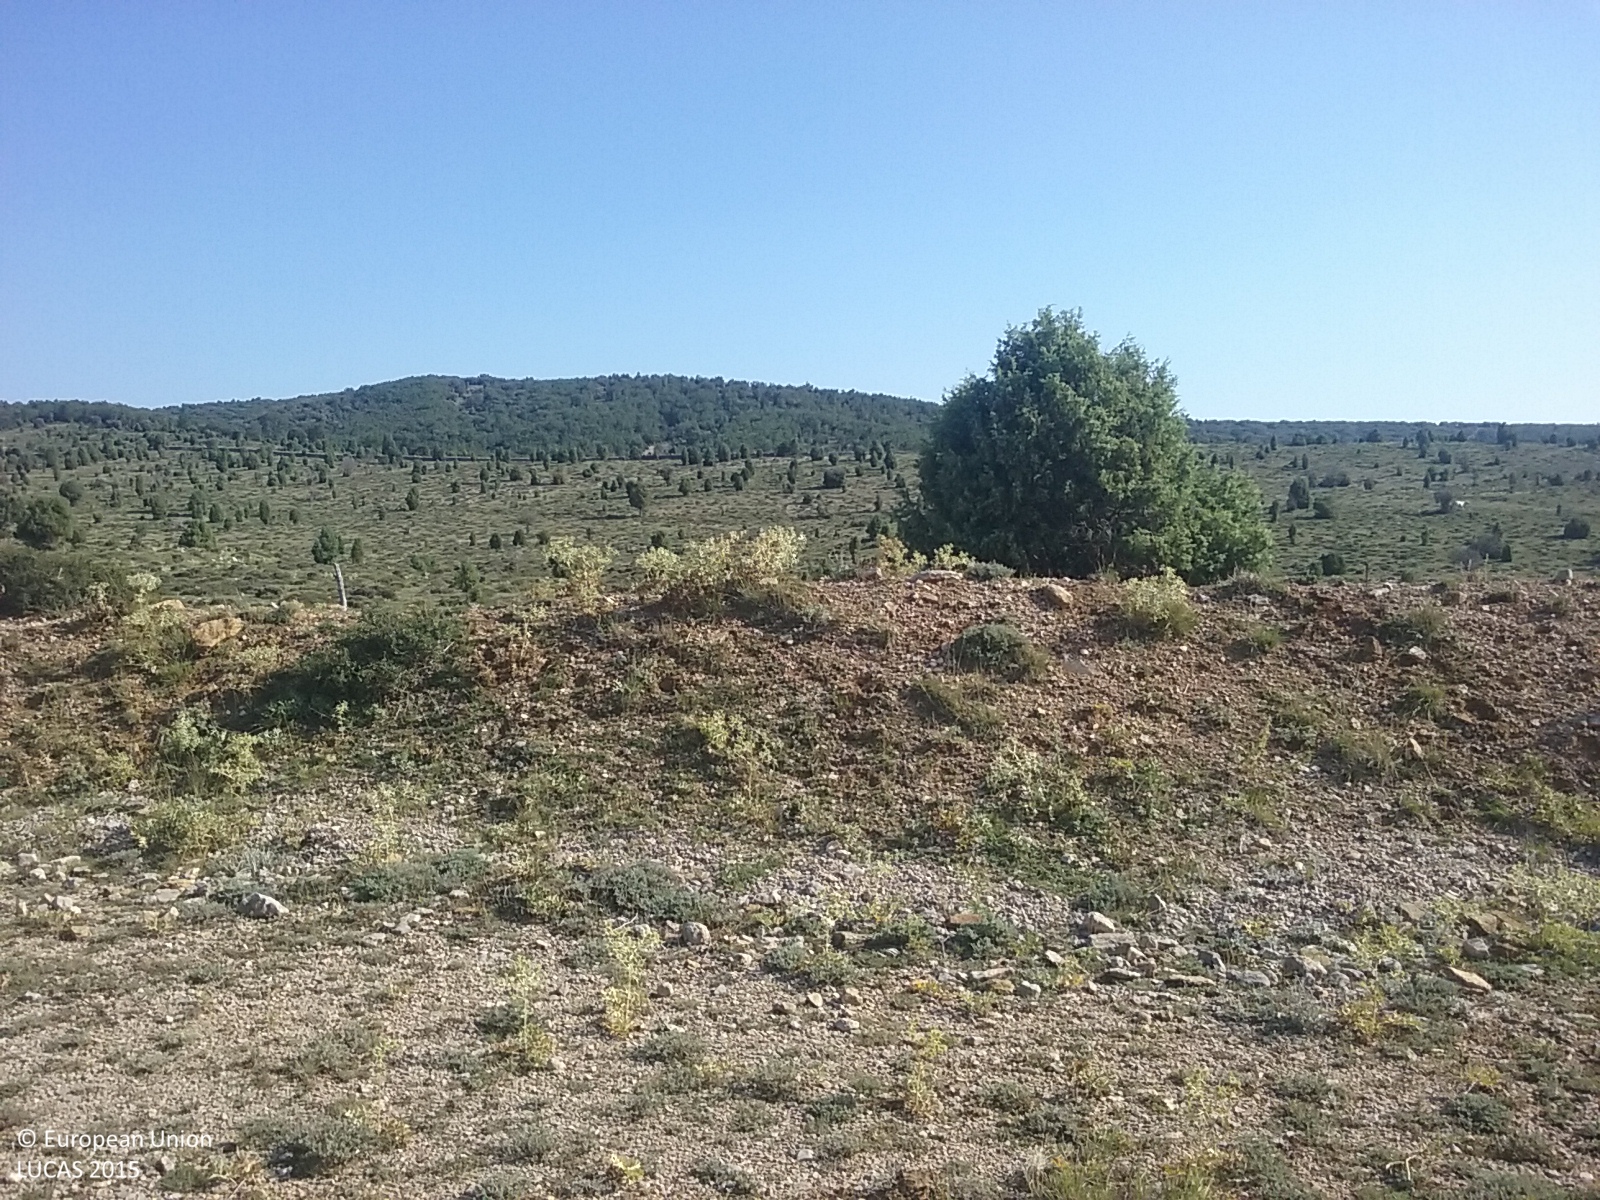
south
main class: Grassland
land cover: Grassland without tree/shrub cover
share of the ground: 10 - 25 %
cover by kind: consolidated bare surface 80 %, herbaceous plants 20 %
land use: Agriculture (excluding fallow land and kitchen gardens)
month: August
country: ES
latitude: 40.5437
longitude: -0.1257
